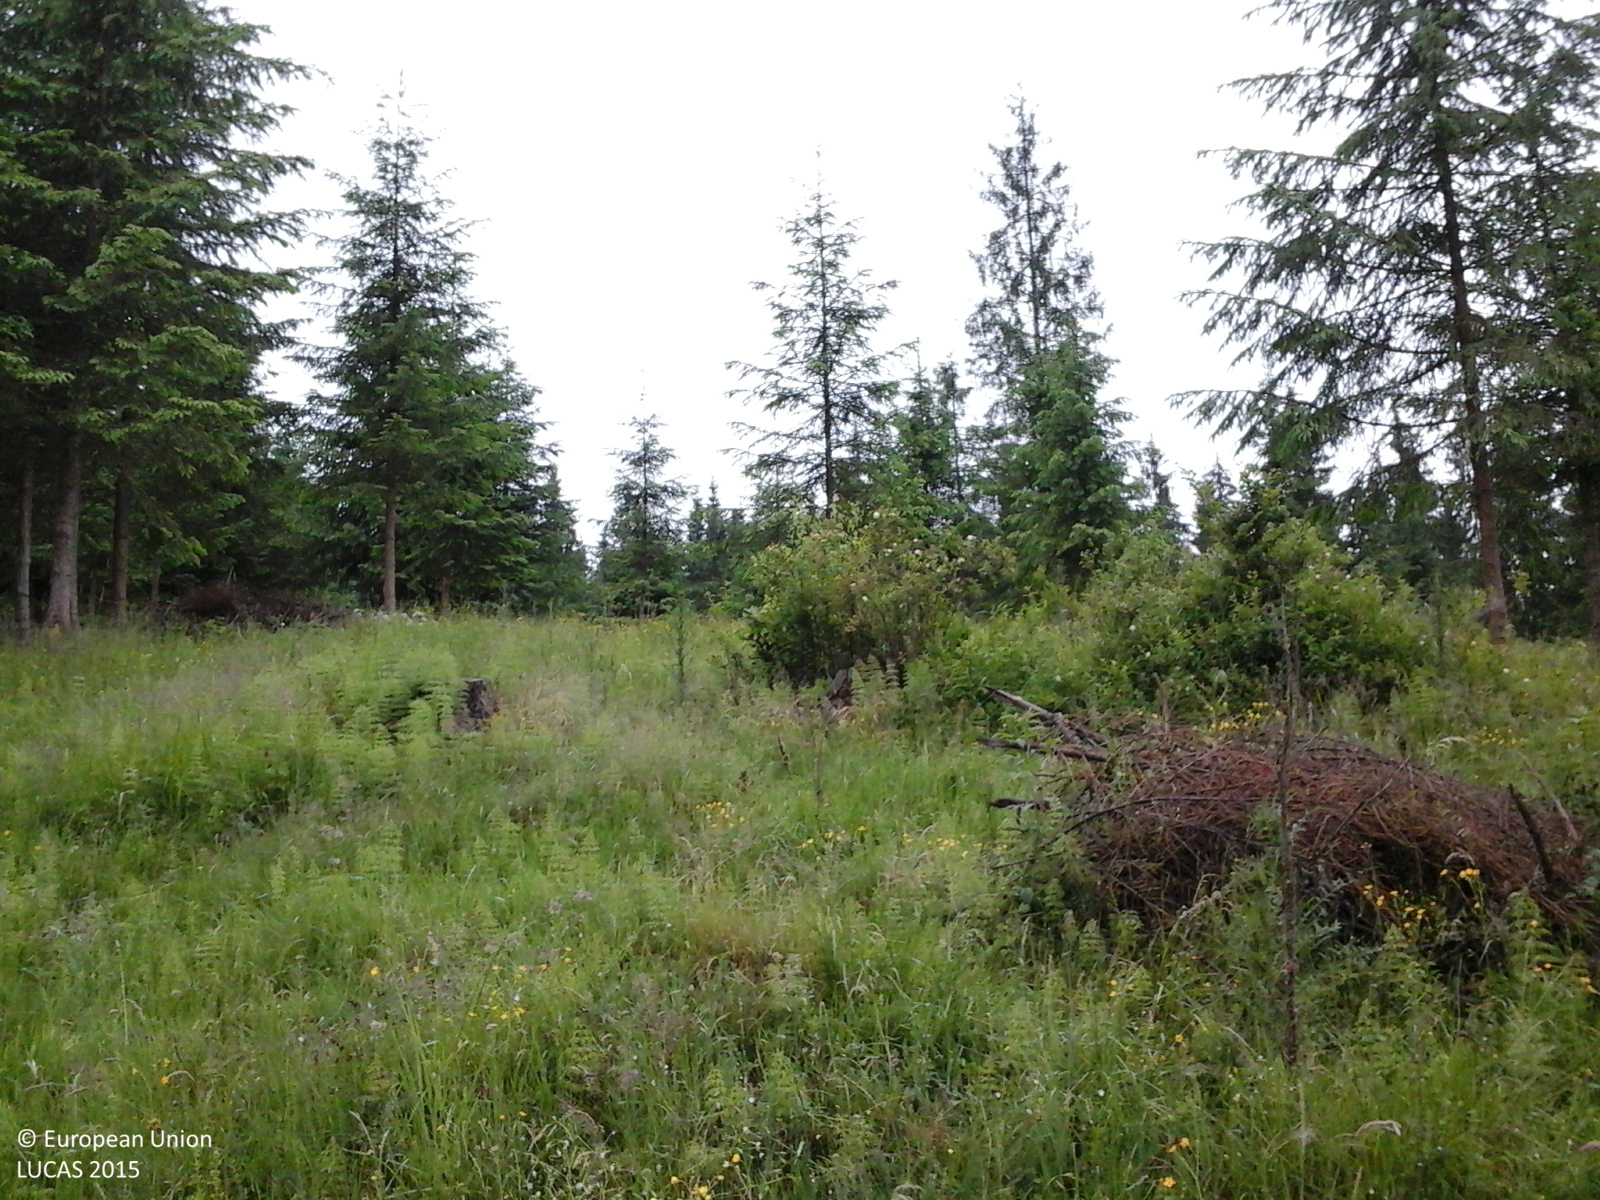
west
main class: Grassland
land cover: Grassland with sparse tree/shrub cover
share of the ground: > 75 %
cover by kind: herbaceous plants 85 %, shrubs 10 %, coniferous forest trees 5 %
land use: Agriculture (excluding fallow land and kitchen gardens)
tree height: > 5 m
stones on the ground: < 10 %
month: June
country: RO
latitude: 47.6029
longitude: 25.3156
